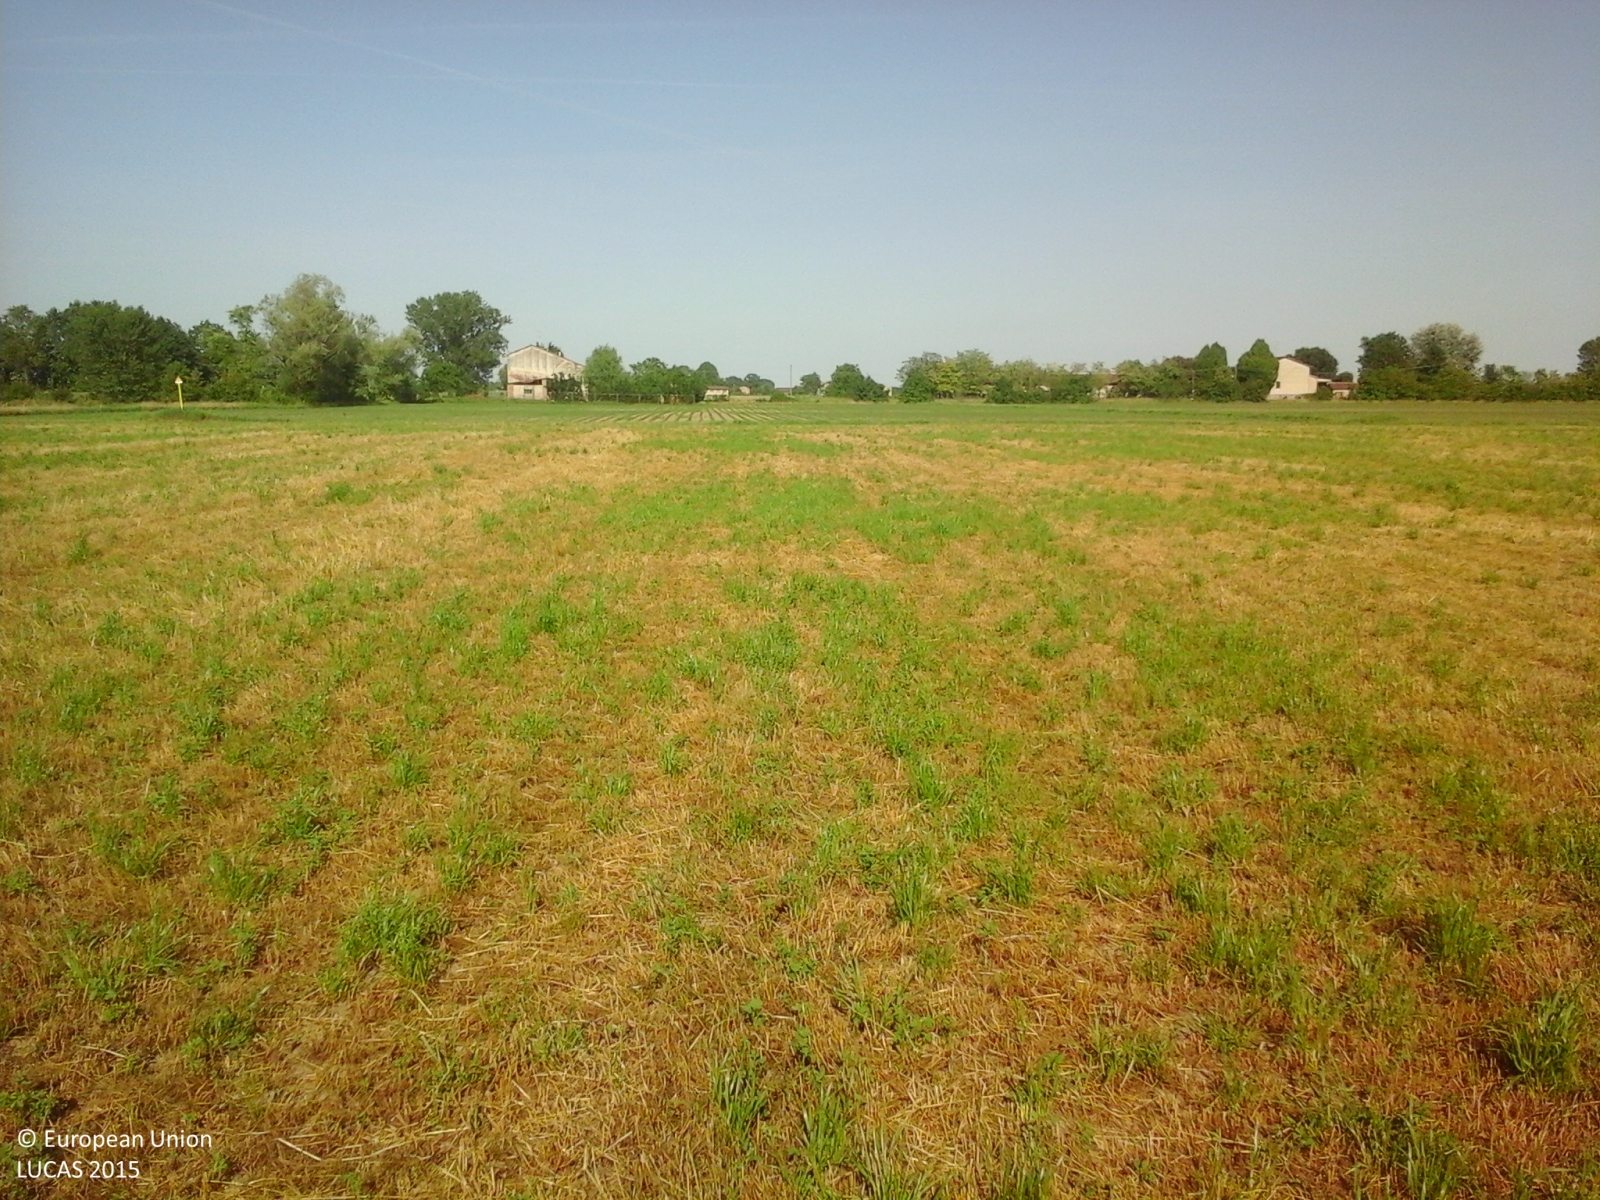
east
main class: Cropland
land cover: Lucerne
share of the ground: > 75 %
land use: Agriculture (excluding fallow land and kitchen gardens)
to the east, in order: Lucerne; Ditches and canals; Maize; Ditches and canals; Maize
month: May
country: IT
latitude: 45.0139
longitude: 10.8992
